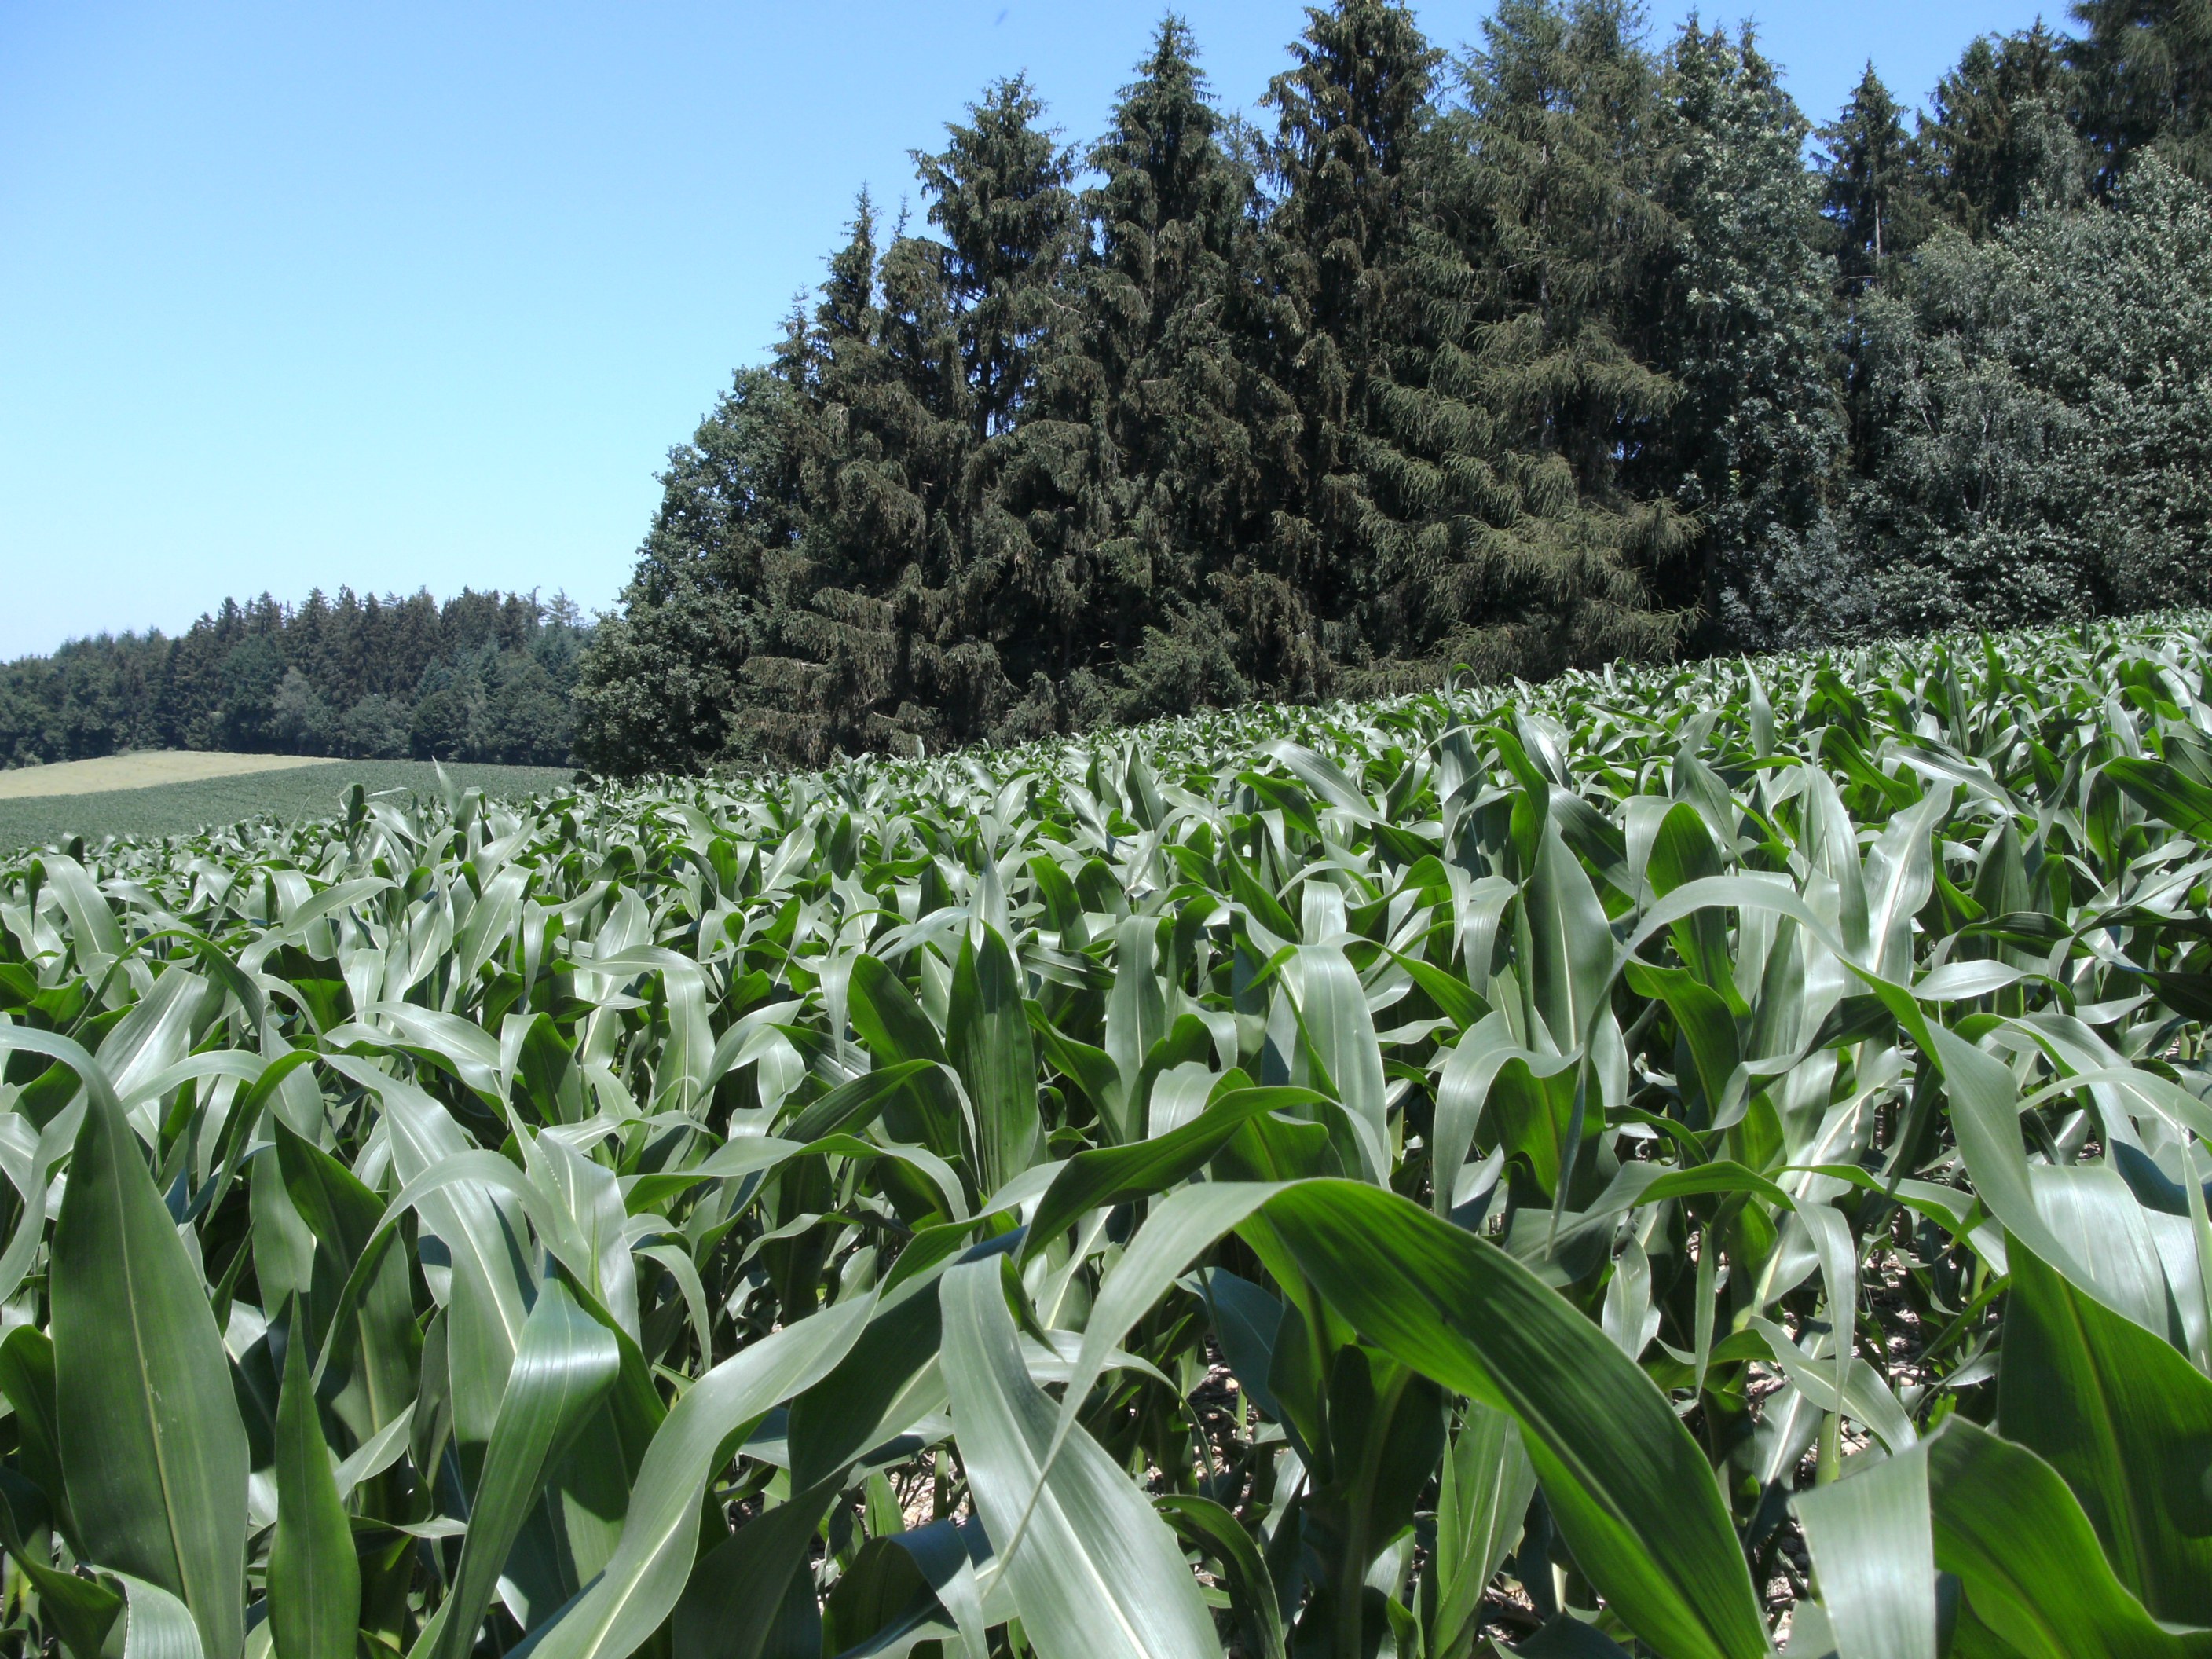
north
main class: Cropland
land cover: Maize
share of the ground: > 75 %
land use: Agriculture (excluding fallow land and kitchen gardens)
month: July
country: AT
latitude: 48.2079
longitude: 13.3768
